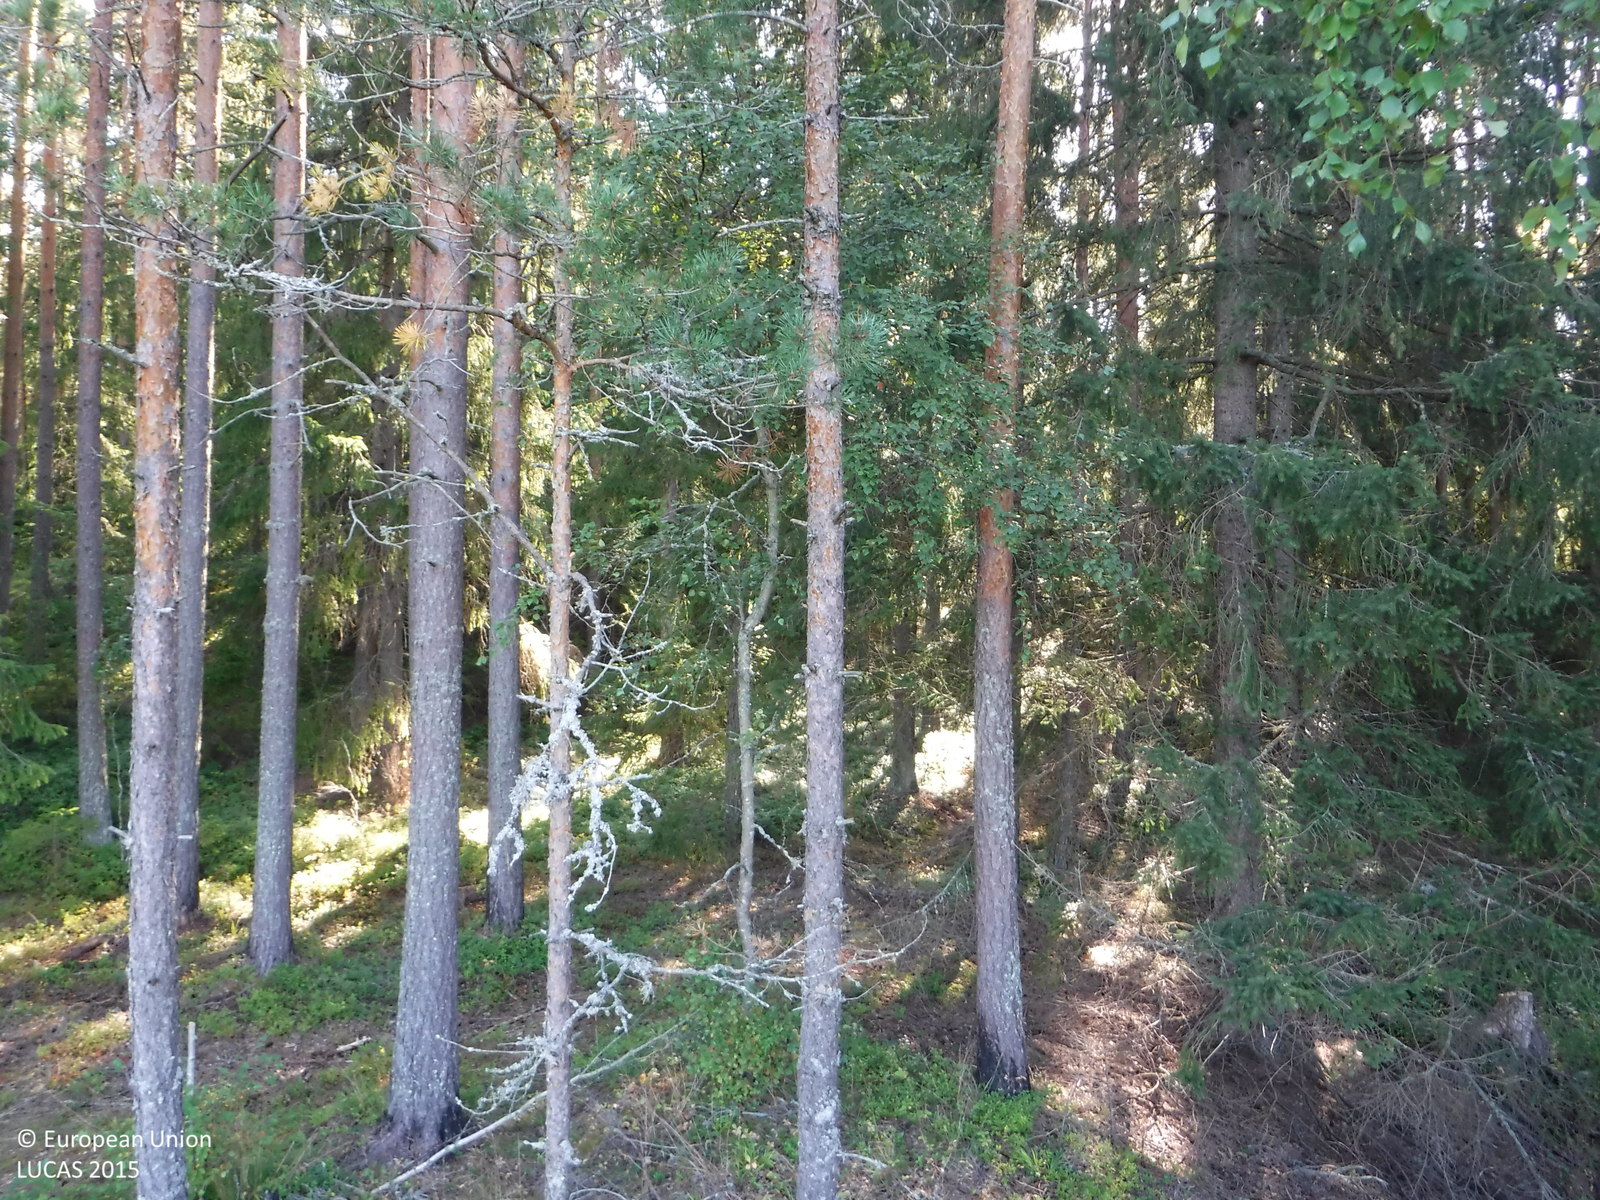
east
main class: Woodland
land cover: Broadleaved woodland
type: mire and swamp forests
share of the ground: 25 - 50 %
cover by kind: herbaceous plants 70 %, broadleaved forest trees 30 %
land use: Semi-natural and natural areas not in use
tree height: > 5 m
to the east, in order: Broadleaved woodland; Inland marshes; Inland fresh water bodies; Inland marshes; Pine dominated mixed woodland; Peatbogs; Pine dominated coniferous woodland; Tracks; Other coniferous woodland; Ditches and canals; Other coniferous woodland
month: August
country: FI
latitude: 61.1356
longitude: 21.6610
